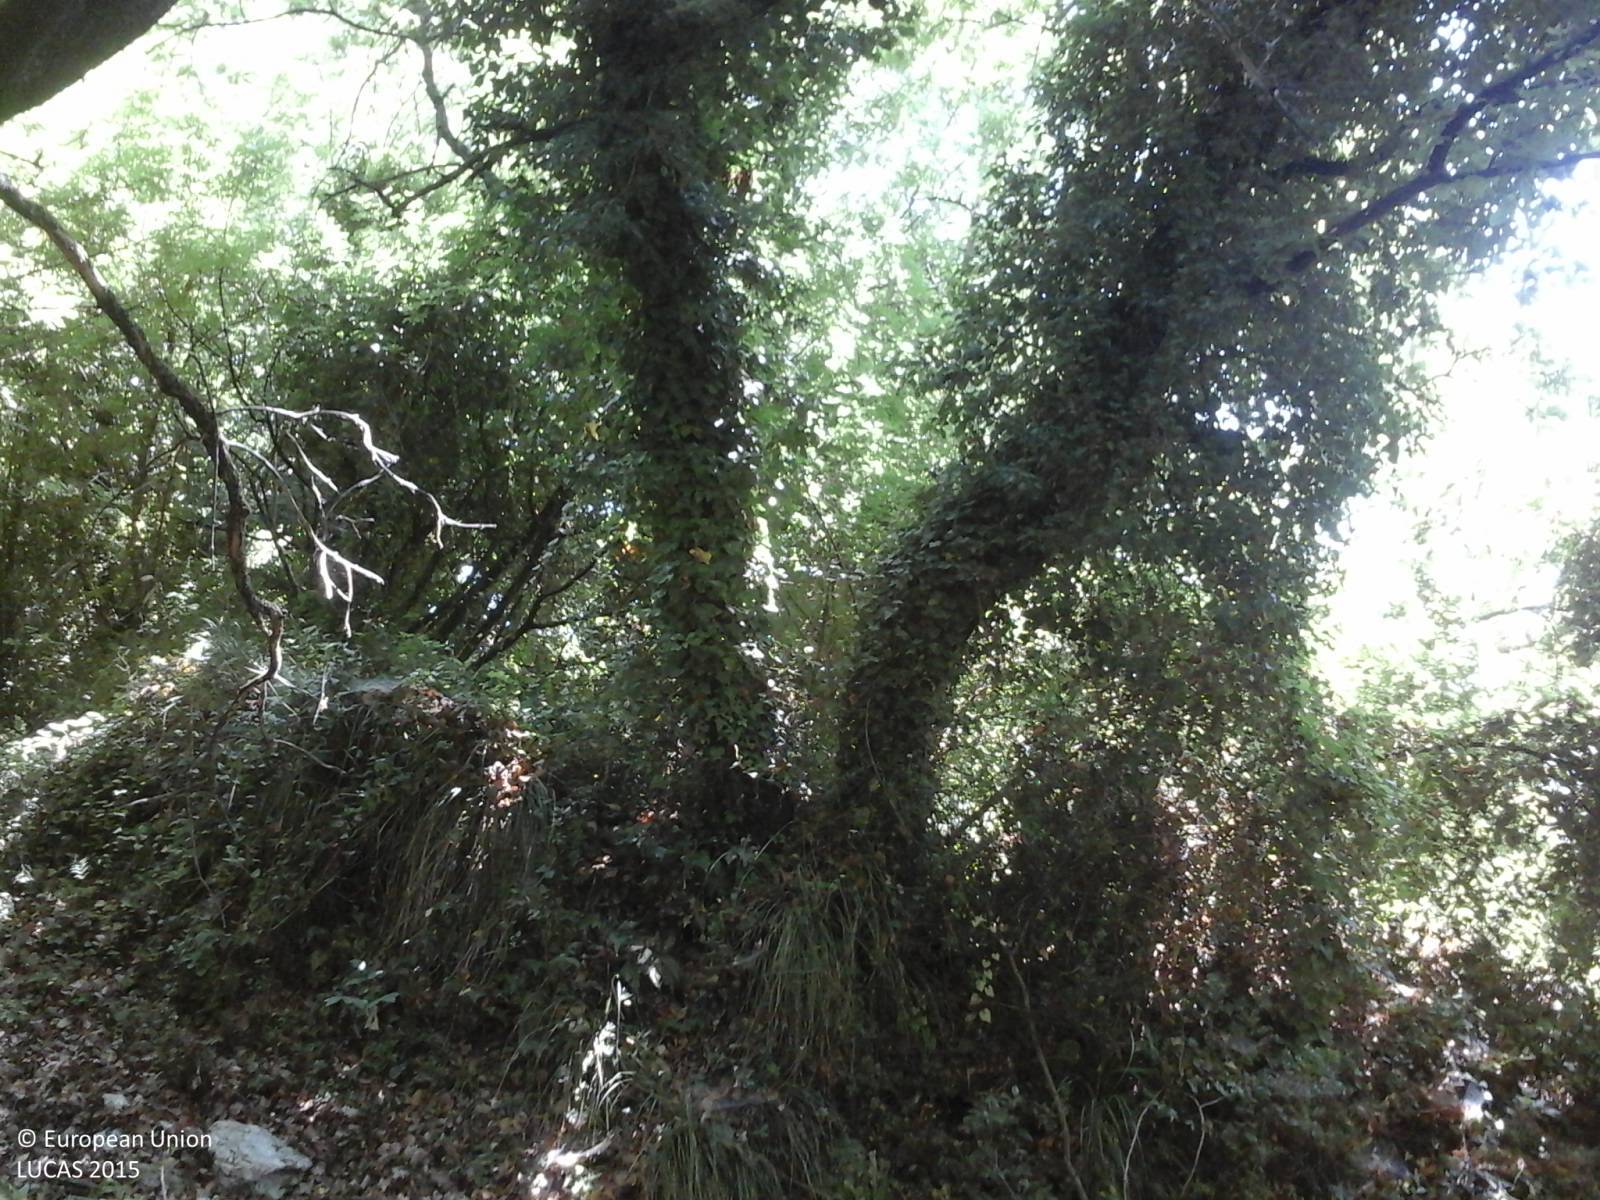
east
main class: Woodland
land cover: Broadleaved woodland
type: thermophilous deciduous forest
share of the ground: > 75 %
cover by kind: broadleaved forest trees 100 %
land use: Forestry
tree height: < 5 m
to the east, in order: Broadleaved woodland; Artificial constructions in urban areas; Broadleaved woodland
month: June
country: IT
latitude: 41.3205
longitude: 14.1535
